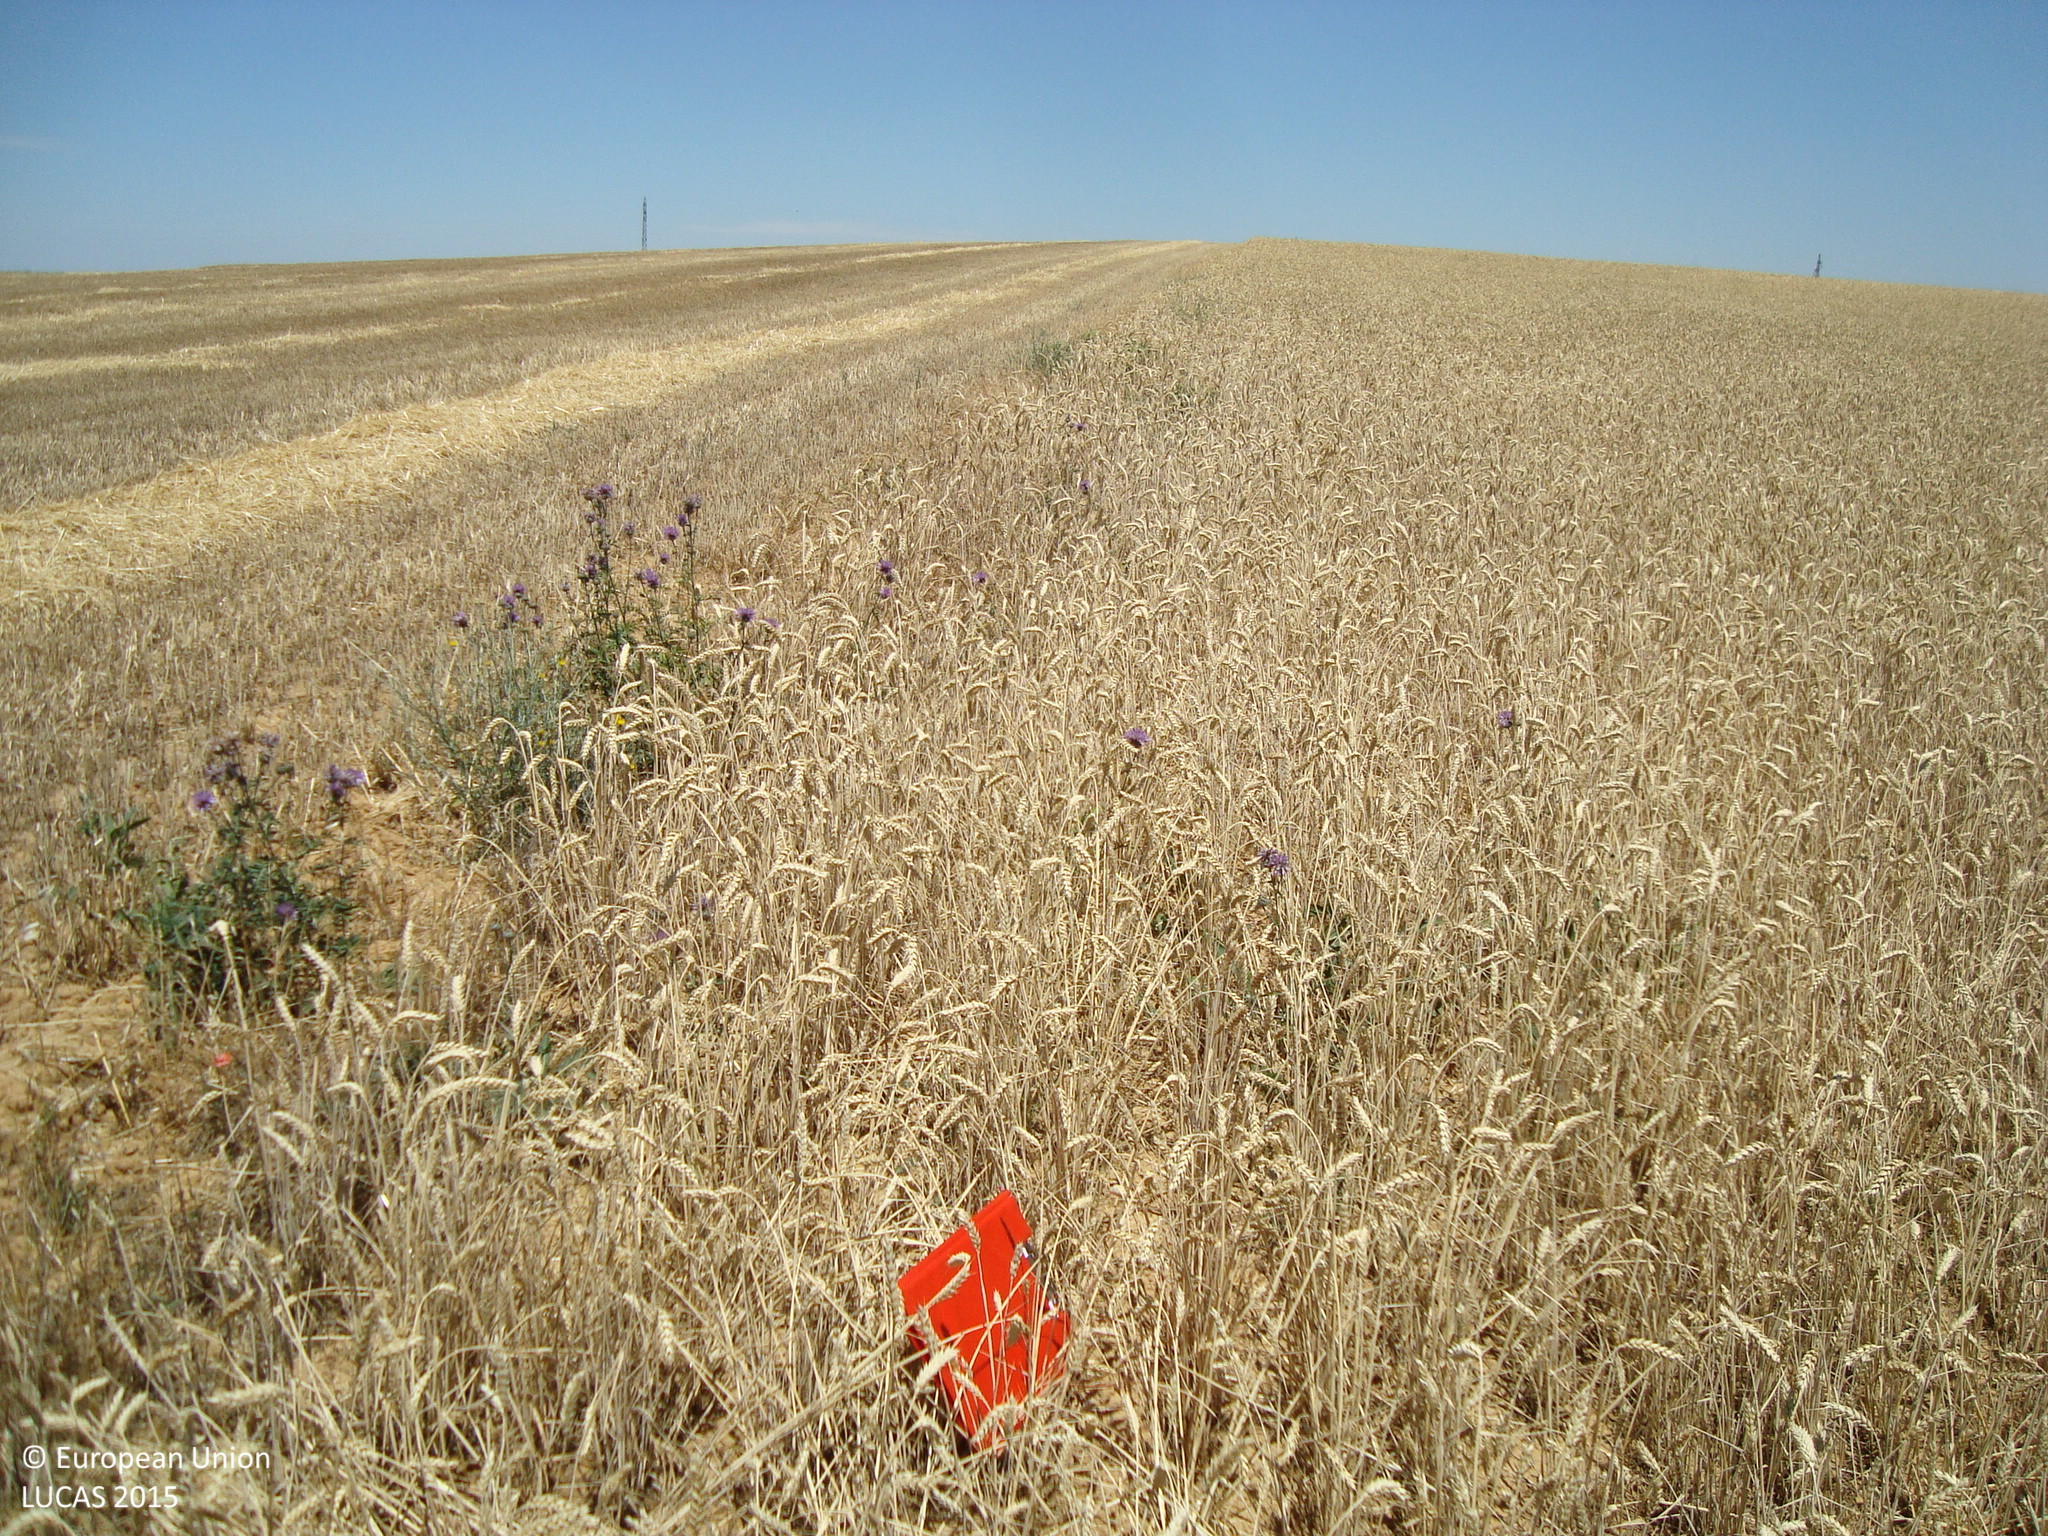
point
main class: Cropland
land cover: Common wheat
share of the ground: > 75 %
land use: Agriculture (excluding fallow land and kitchen gardens)
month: July
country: ES
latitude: 42.1495
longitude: -4.7791
